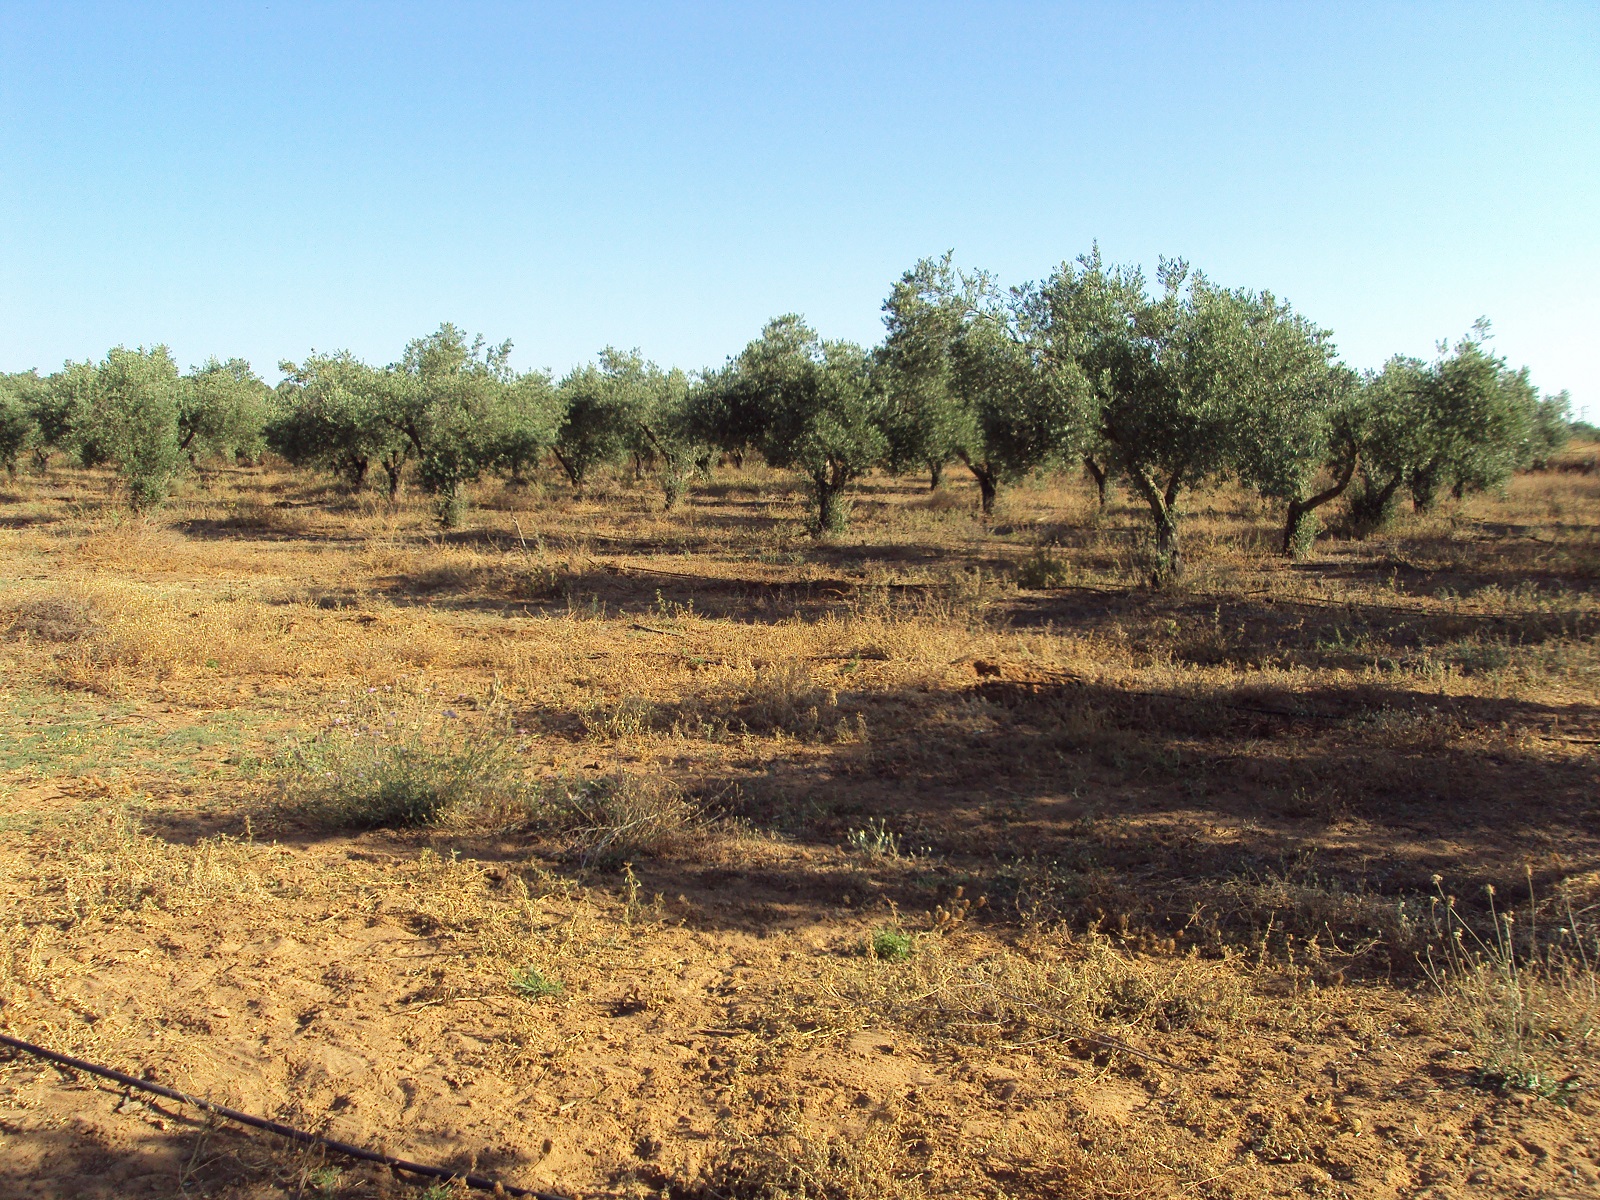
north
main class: Cropland
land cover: Olive groves
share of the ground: 50 - 75 %
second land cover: Spontaneously vegetated surfaces
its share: > 75 %
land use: Agriculture (excluding fallow land and kitchen gardens)
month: June
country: ES
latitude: 37.3430
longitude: -6.9378
